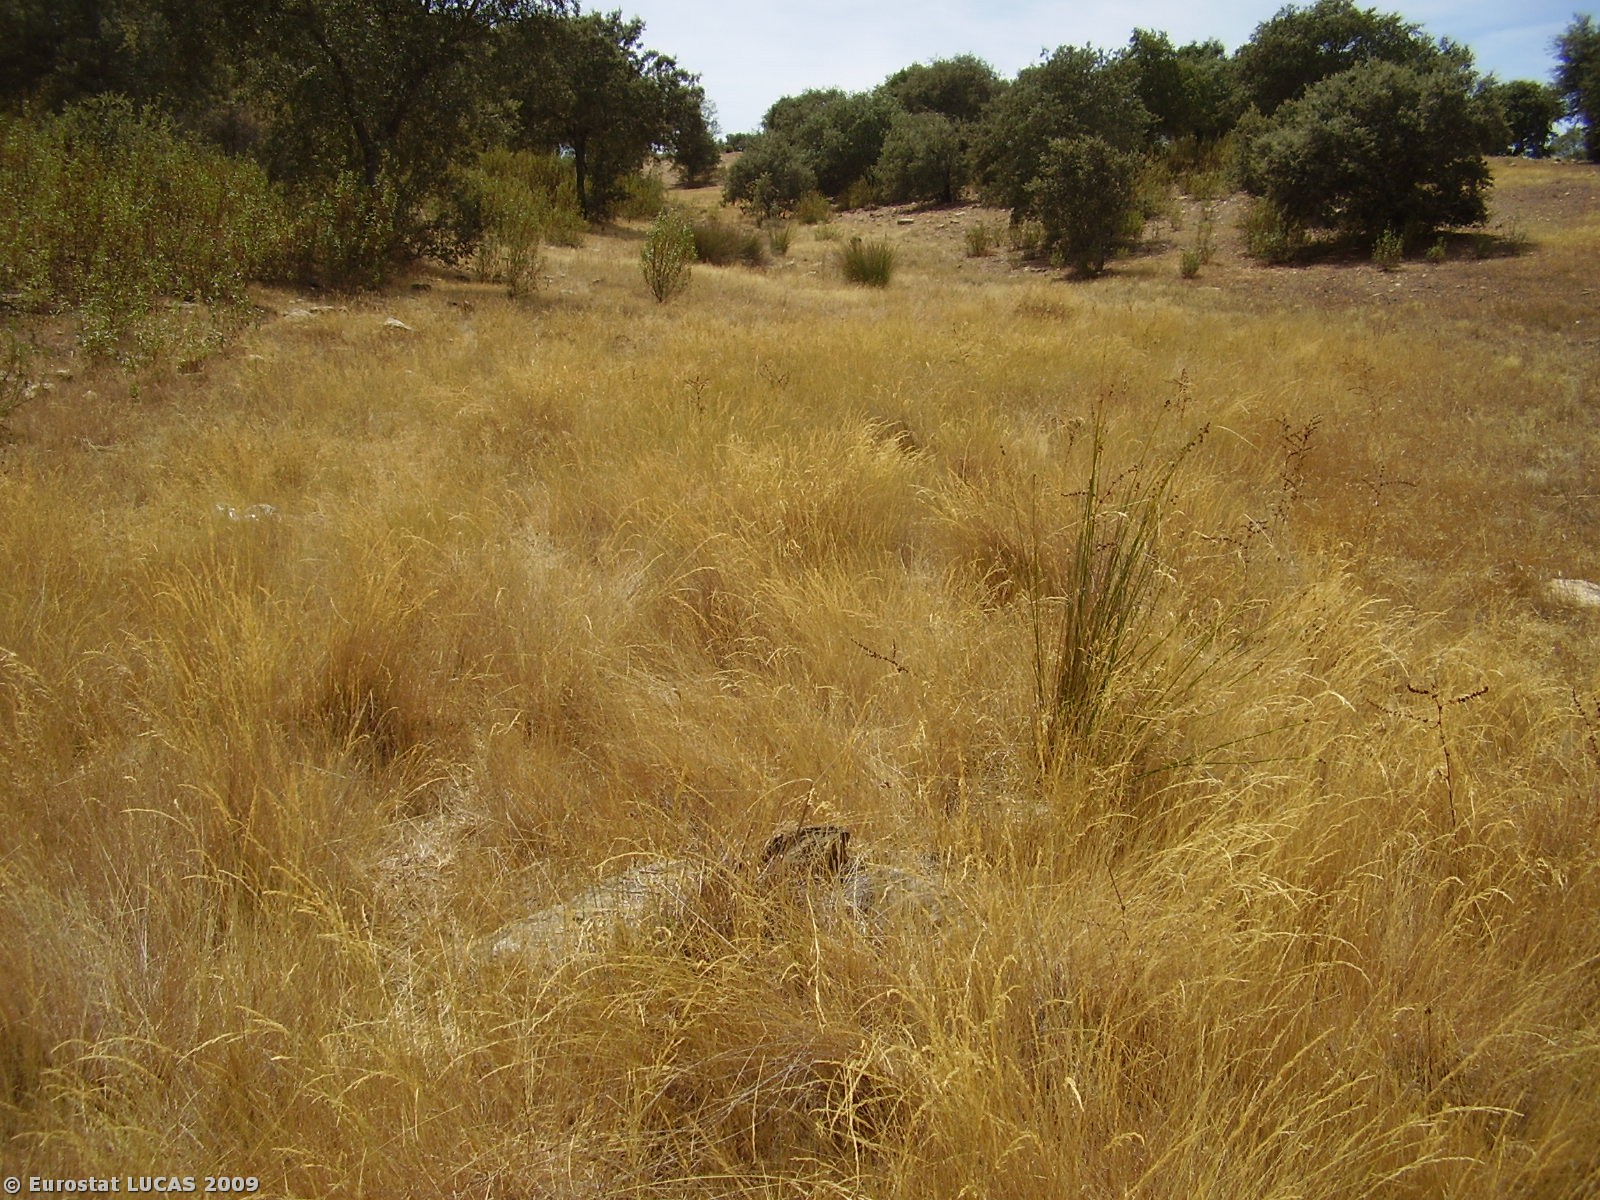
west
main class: Grassland
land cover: Grassland with sparse tree/shrub cover
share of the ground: > 75 %
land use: Forestry
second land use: Agriculture (excluding fallow land and kitchen gardens)
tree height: > 5 m
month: July
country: PT
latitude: 38.5665
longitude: -7.8150
